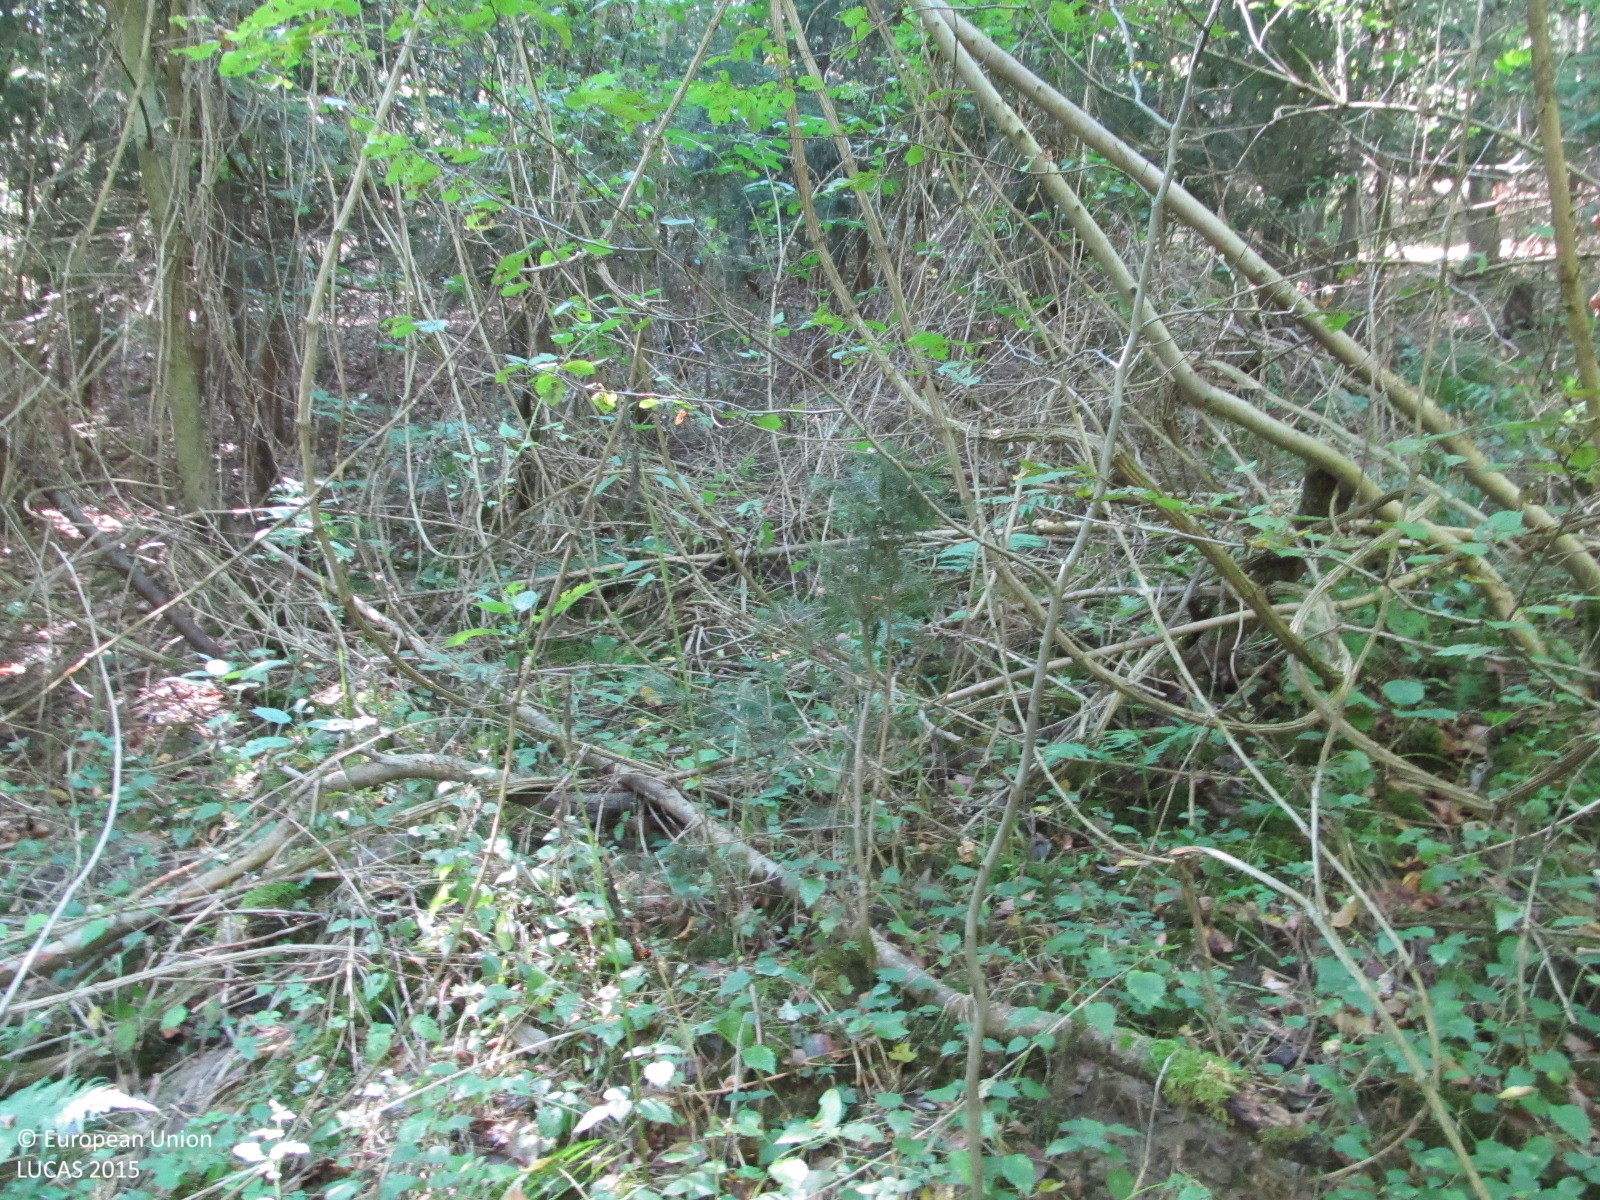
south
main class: Woodland
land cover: Other mixed woodland
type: hemiboreal forest and nemoral coniferous forest and mixed broadleaved-coniferous forest
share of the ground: > 75 %
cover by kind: broadleaved forest trees 55 %, coniferous forest trees 25 %, shrubs 10 %, unconsolidated bare surface 10 %
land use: Forestry
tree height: > 5 m
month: August
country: AT
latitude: 48.5655
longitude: 15.6541
